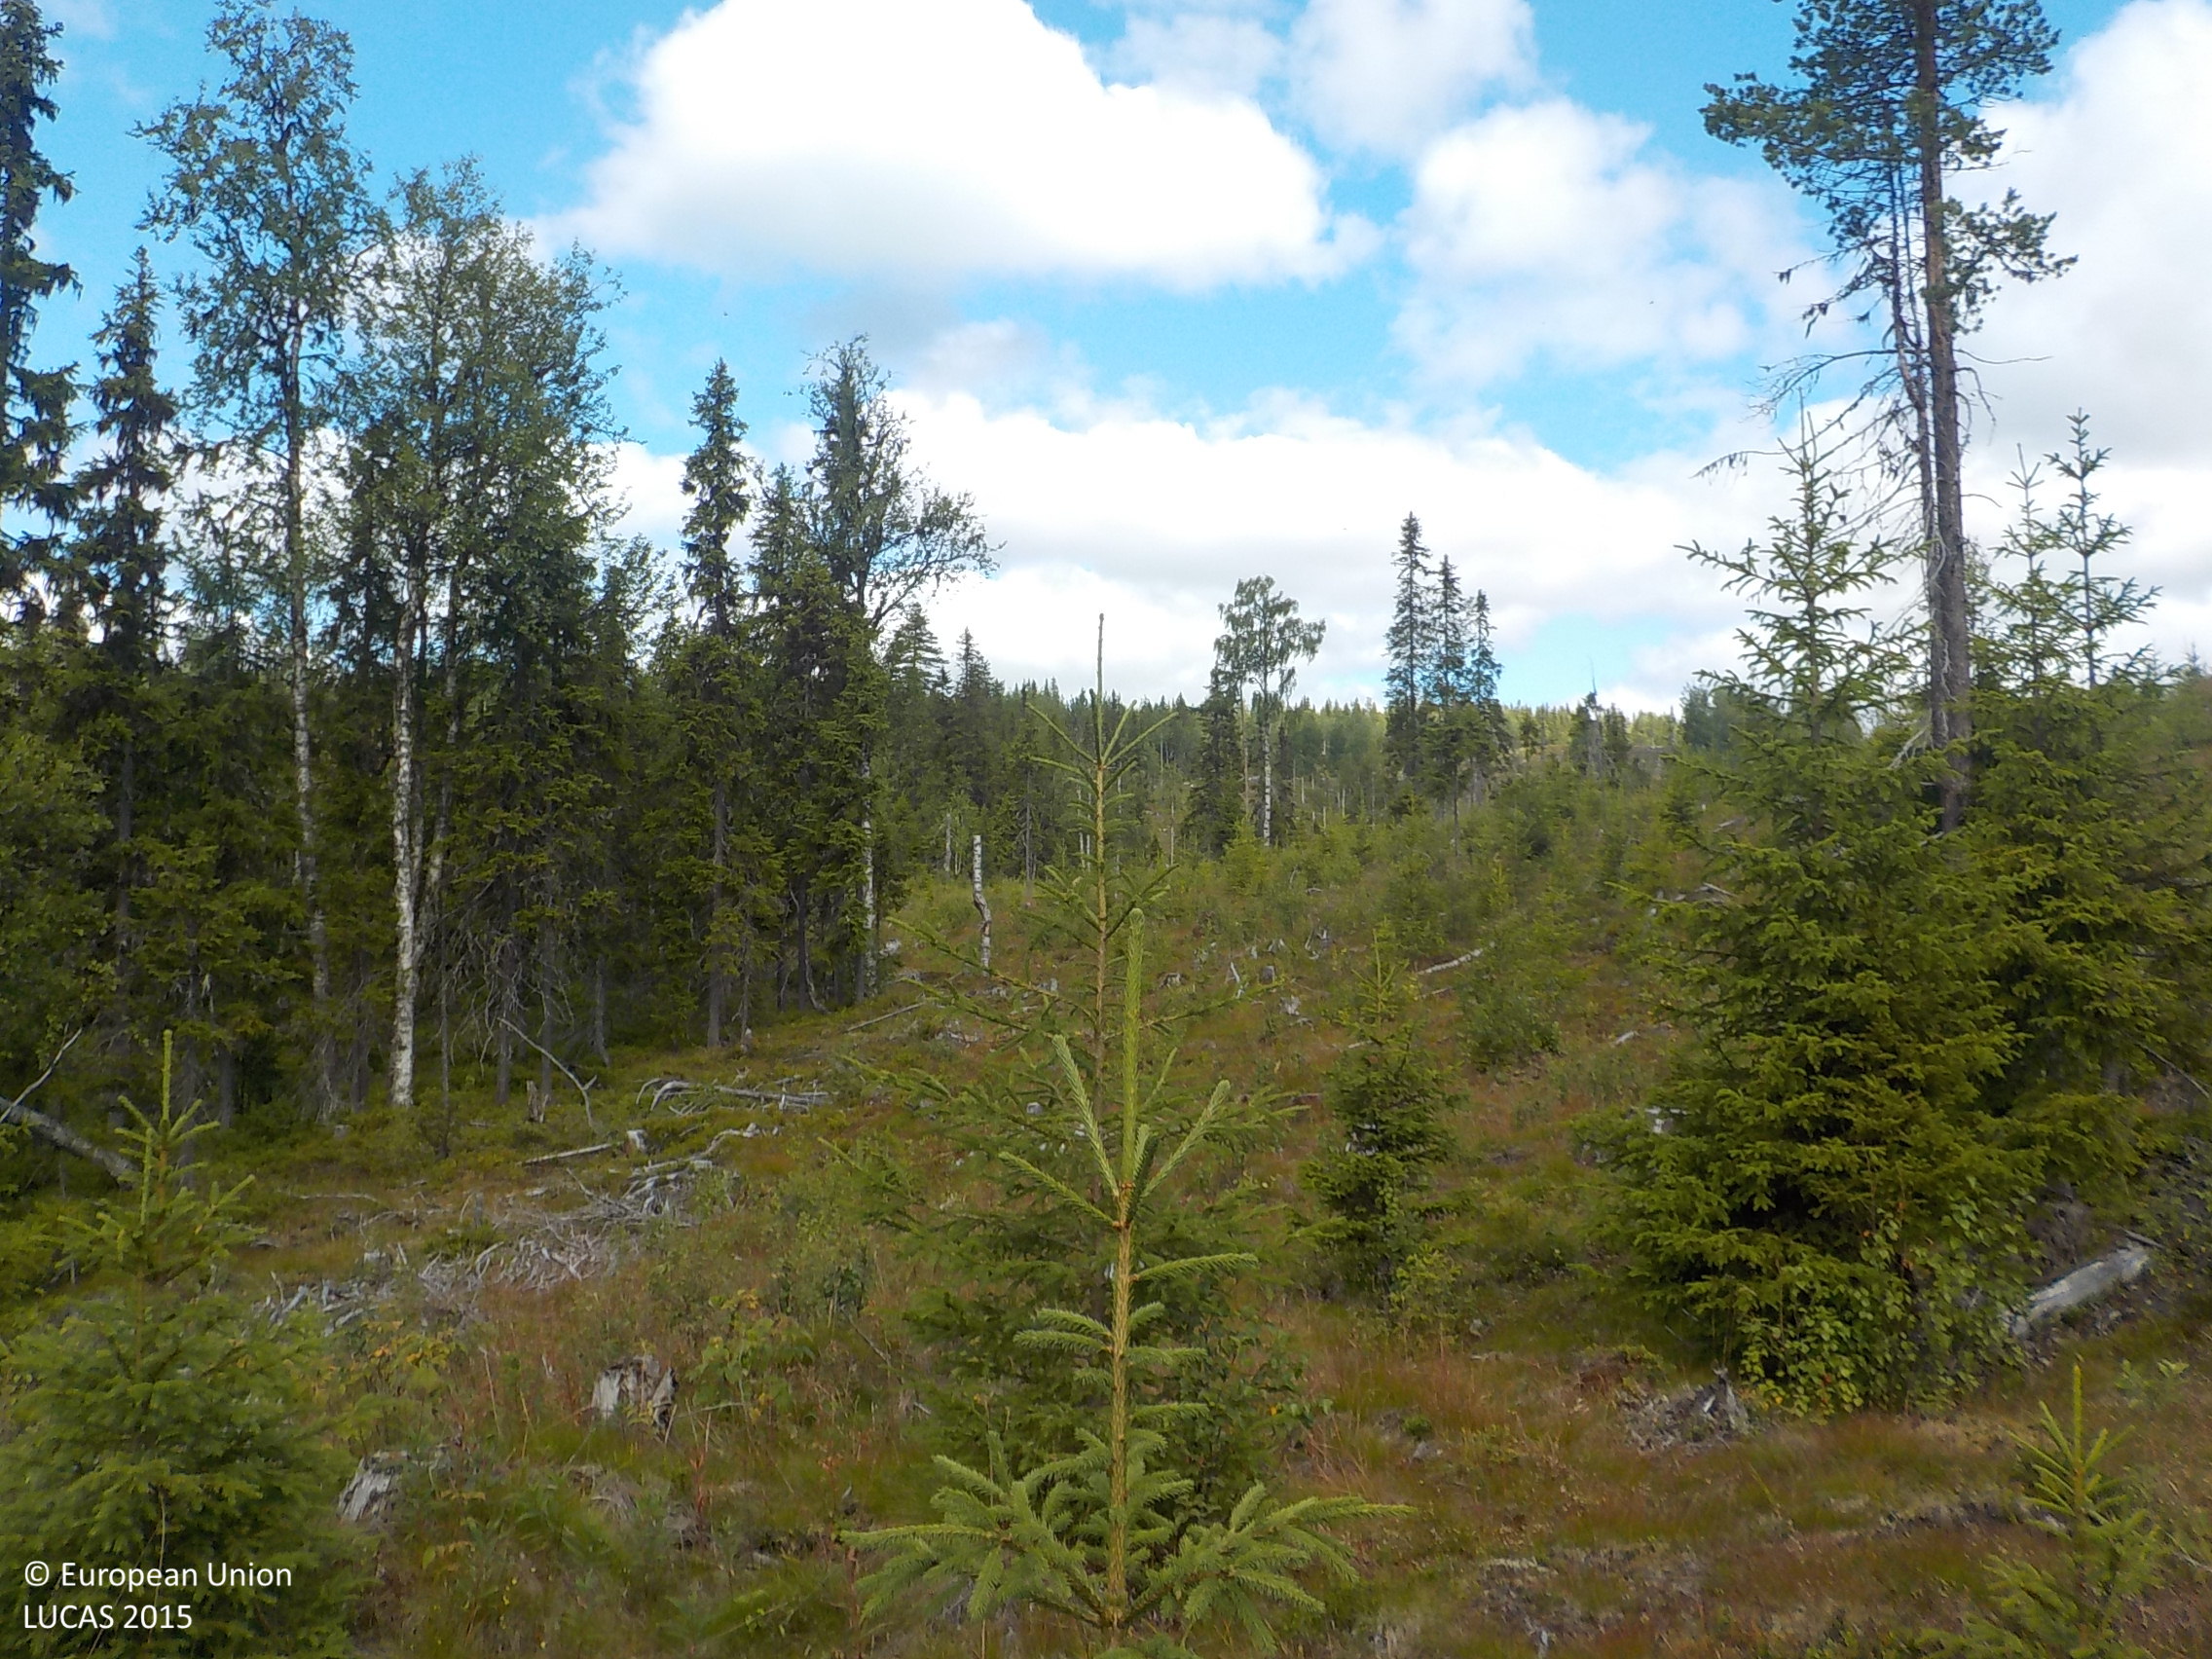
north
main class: Woodland
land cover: Spruce dominated mixed woodland
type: boreal forest
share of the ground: 25 - 50 %
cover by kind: herbaceous plants 60 %, coniferous forest trees 20 %, broadleaved forest trees 10 %, shrubs 5 %, lichens and mosses 5 %
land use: Forestry
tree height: < 5 m
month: August
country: SE
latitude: 64.1238
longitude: 17.6301
